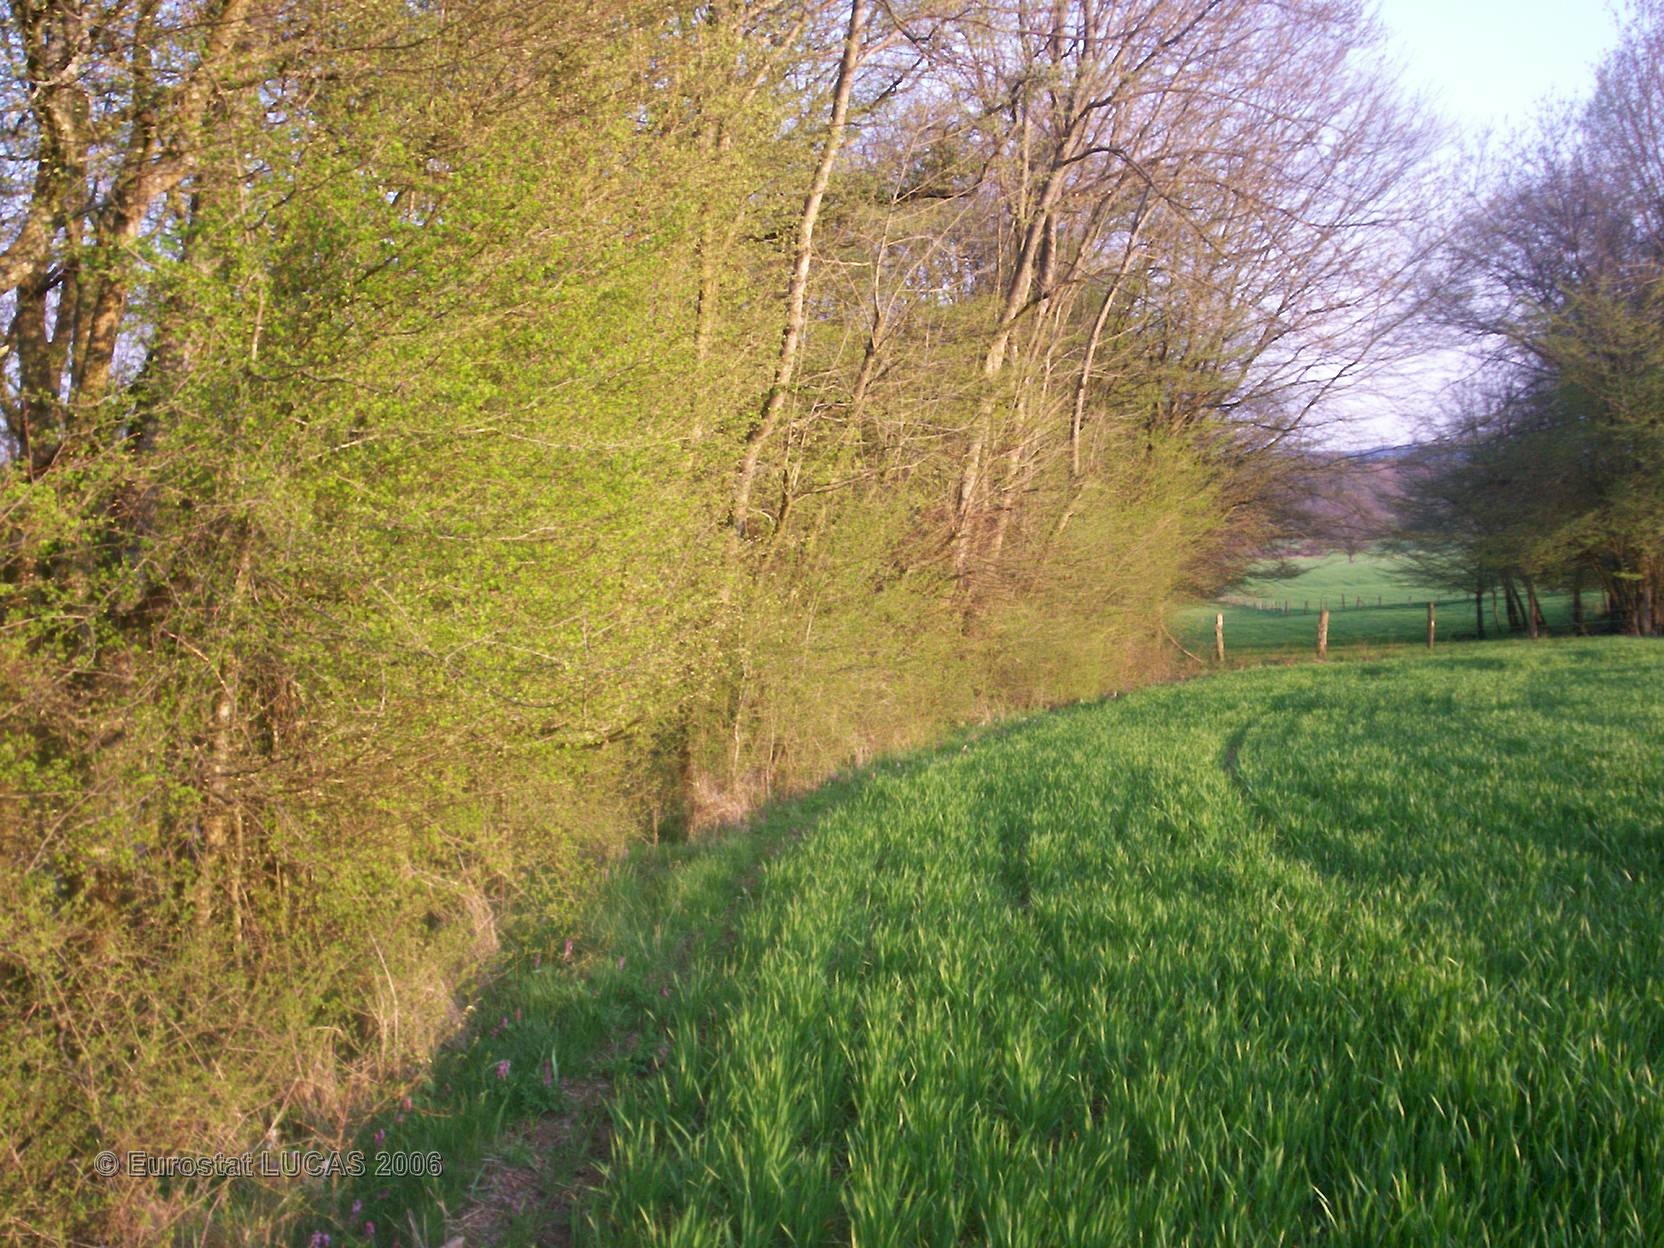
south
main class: Cropland
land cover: Barley
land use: Agriculture (excluding fallow land and kitchen gardens)
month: April
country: FR
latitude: 47.4768
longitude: 6.2994
